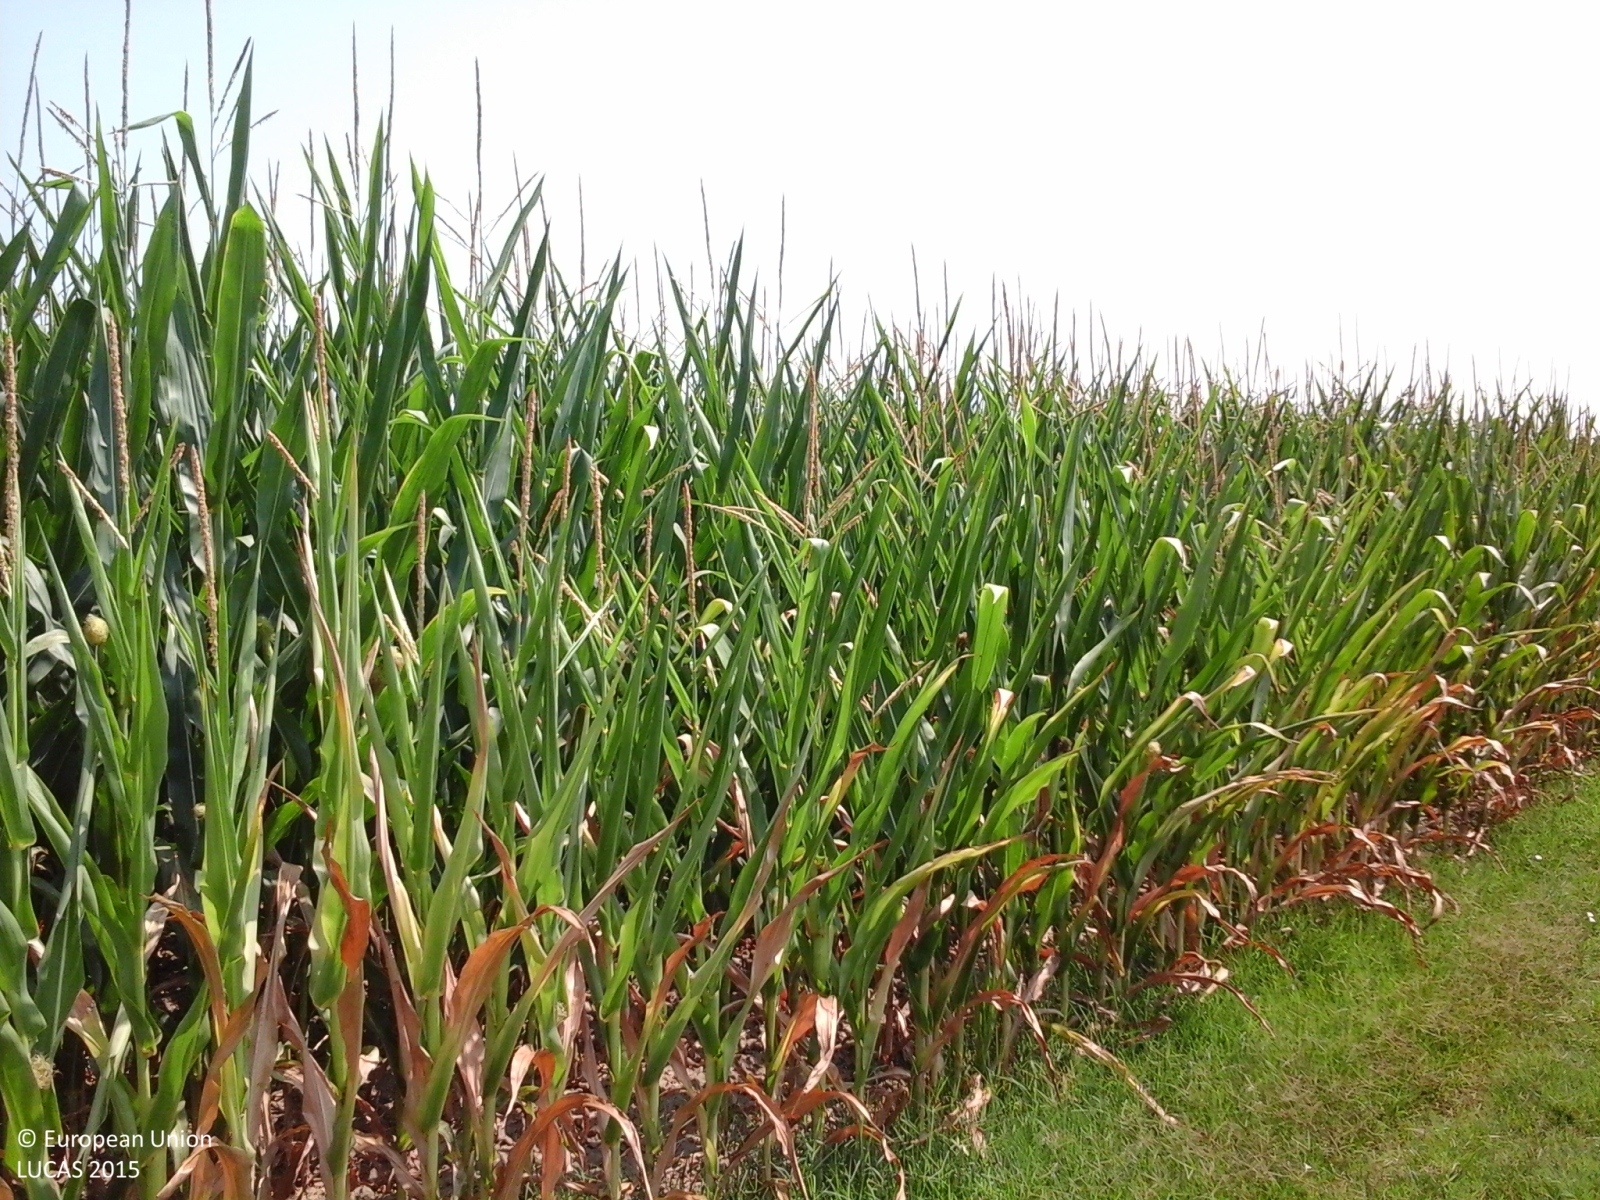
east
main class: Cropland
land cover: Maize
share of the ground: > 75 %
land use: Agriculture (excluding fallow land and kitchen gardens)
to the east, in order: Maize; Ditches and canals; Tracks
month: July
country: IT
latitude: 44.6261
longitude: 11.6477
